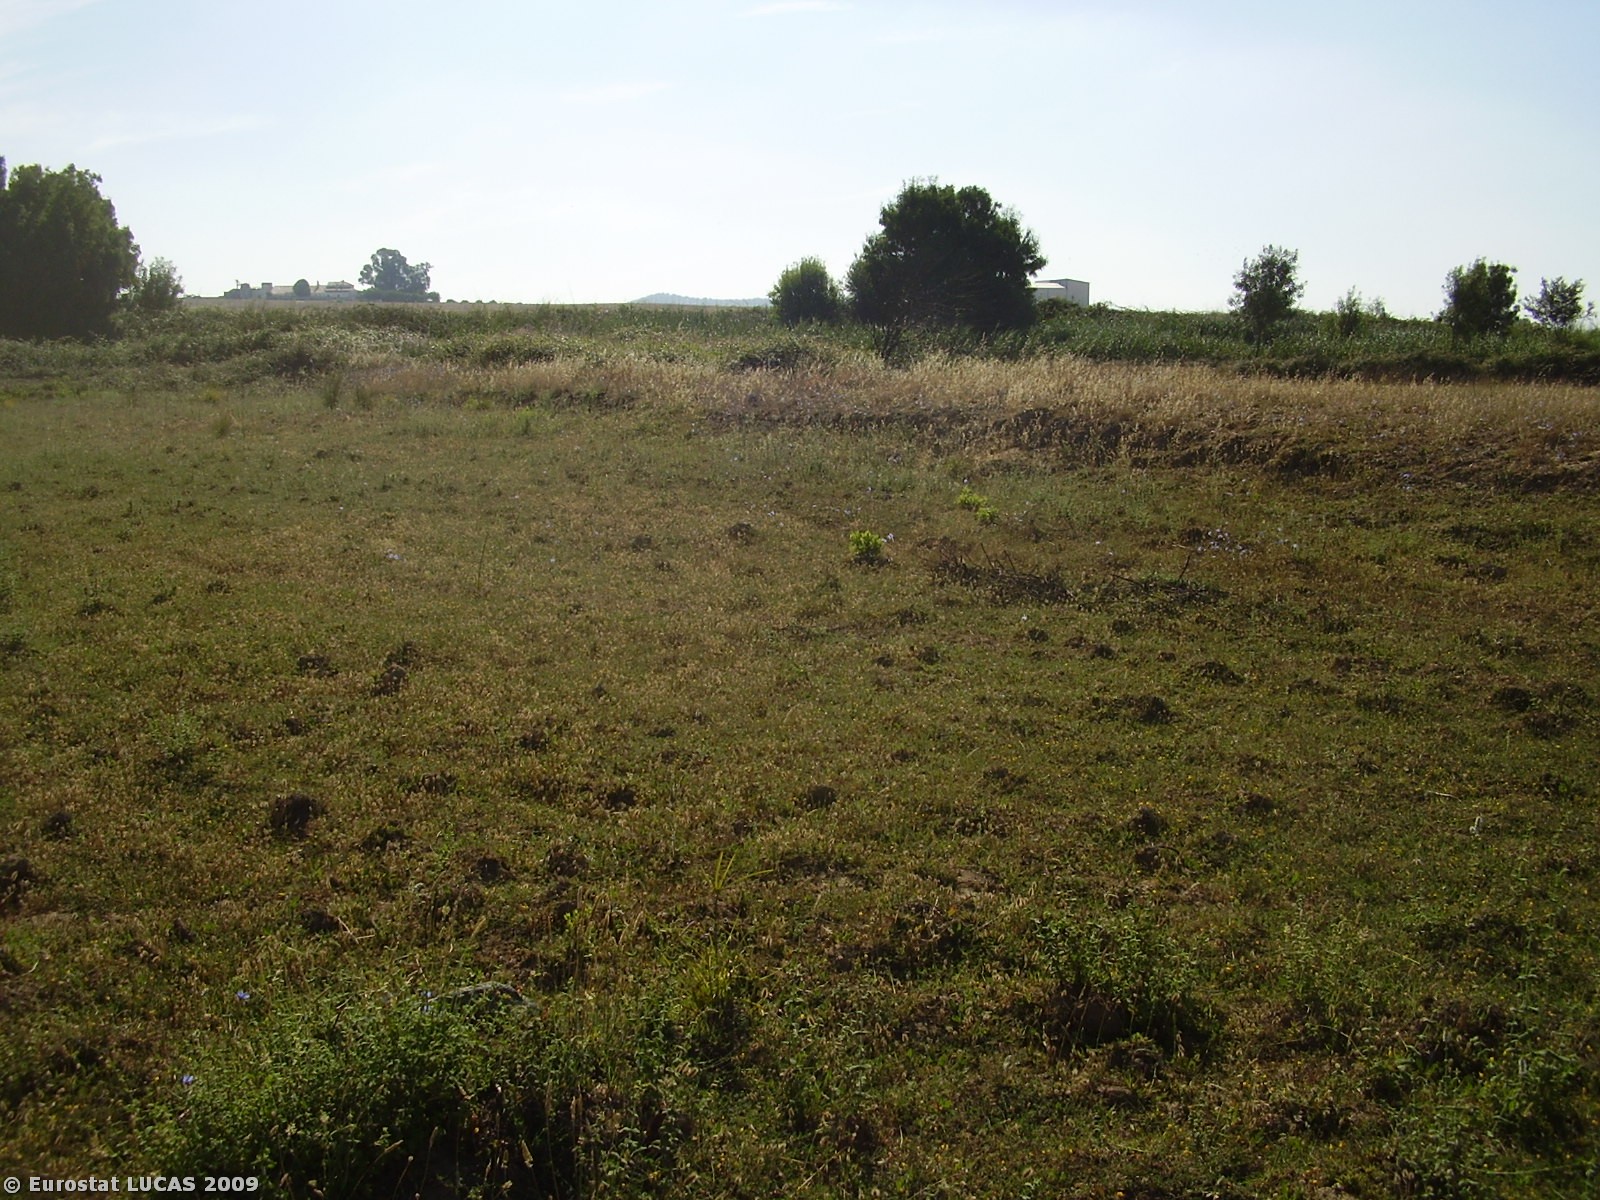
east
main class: Grassland
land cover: Spontaneously vegetated surfaces
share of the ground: > 75 %
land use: Fallow land
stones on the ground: 10 - 25 %
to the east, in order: Spontaneously vegetated surfaces; Shrubland without tree cover; Rivers and streams; Shrubland without tree cover; Tracks; Shrubland without tree cover; Rivers and streams; Shrubland without tree cover; Arable land (only in case pi); Tracks; Arable land (only in case pi)
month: July
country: PT
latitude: 38.7471
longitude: -7.9351
